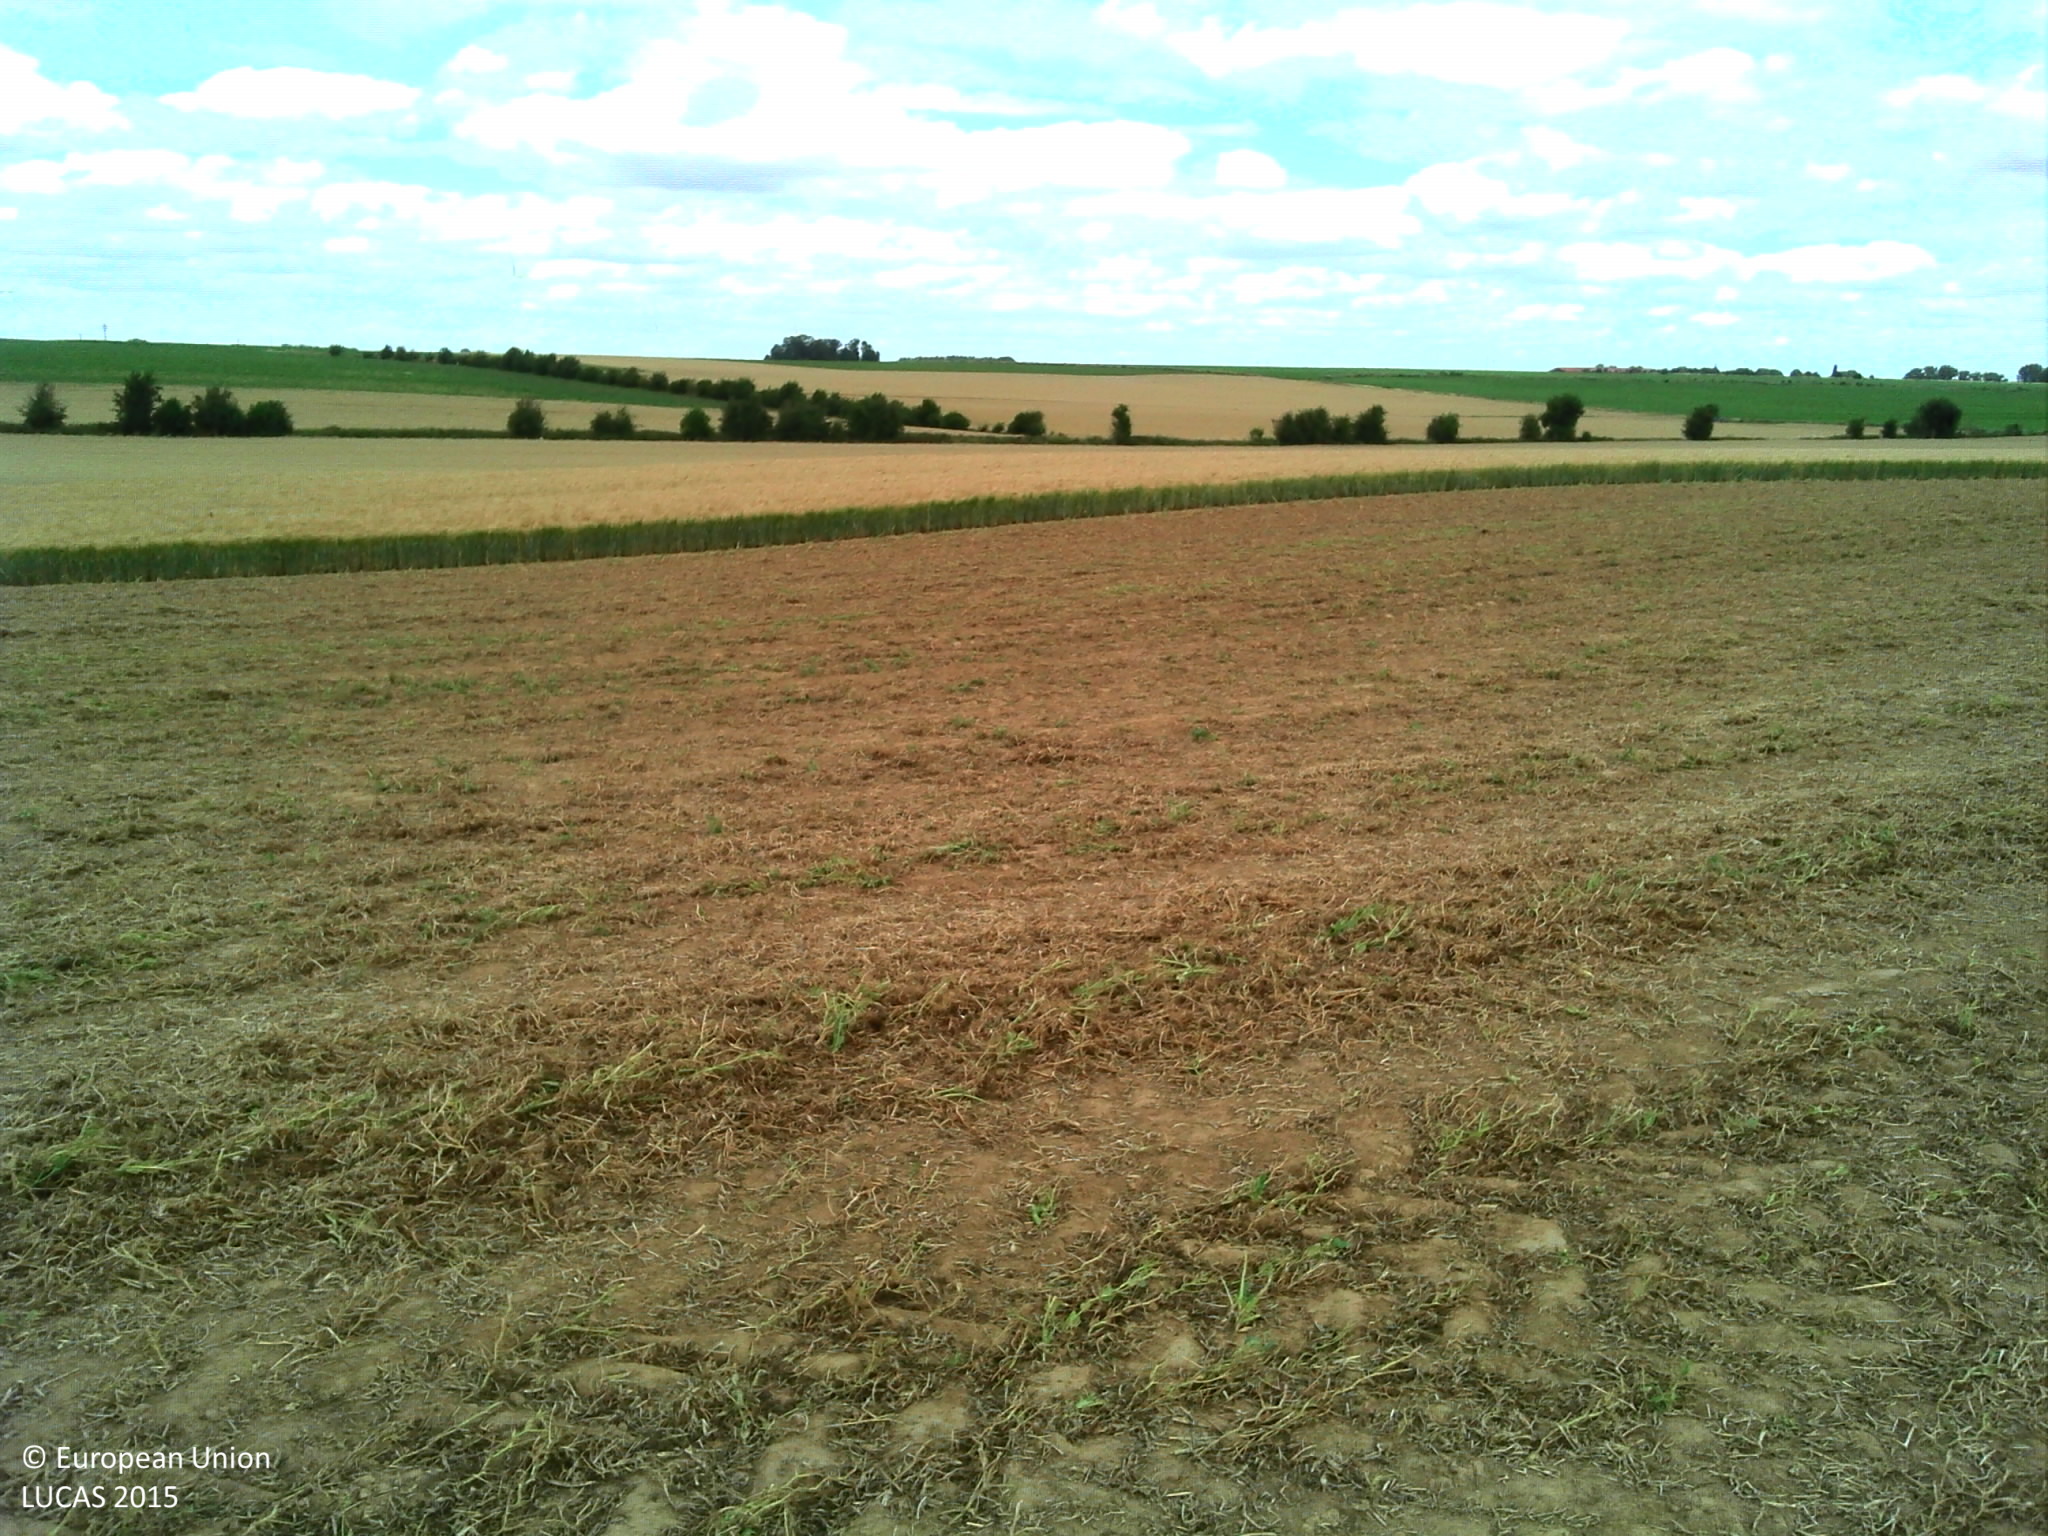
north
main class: Cropland
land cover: Other fresh vegetables
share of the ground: < 10 %
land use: Agriculture (excluding fallow land and kitchen gardens)
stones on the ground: < 10 %
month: July
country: FR
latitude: 50.1199
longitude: 2.8144
